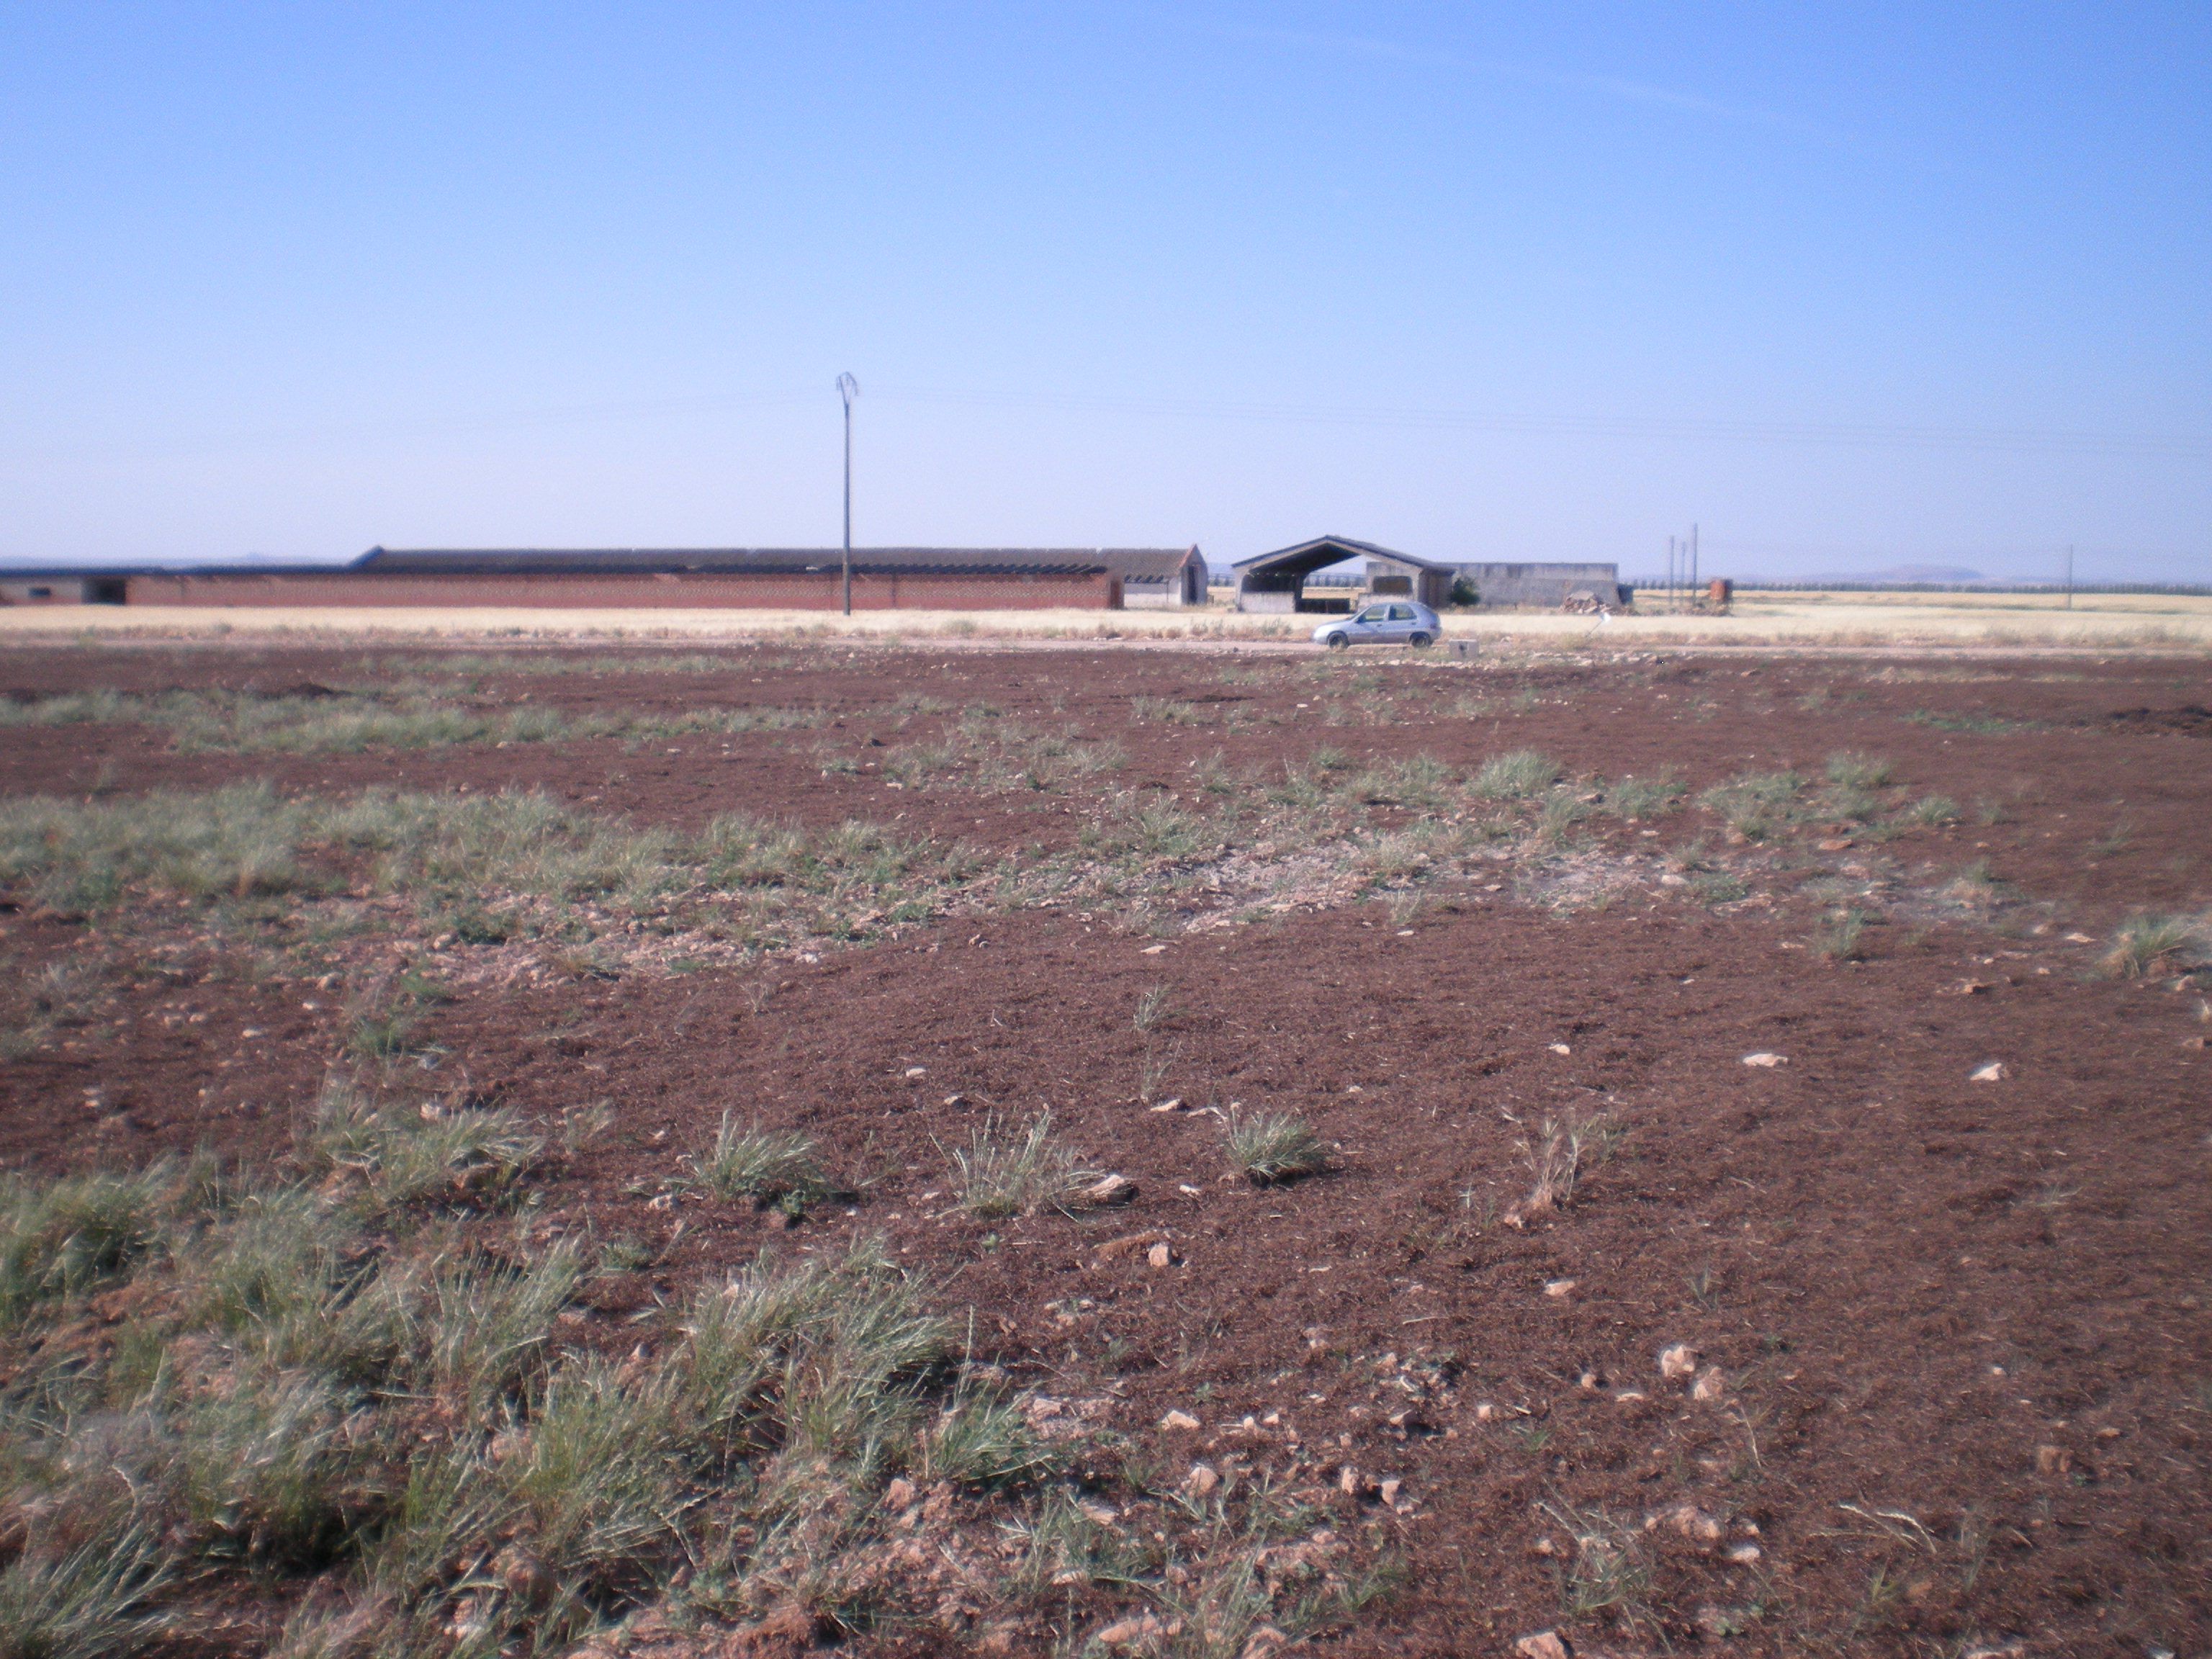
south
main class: Grassland
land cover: Spontaneously vegetated surfaces
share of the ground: 10 - 25 %
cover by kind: unconsolidated bare surface 85 %, herbaceous plants 15 %
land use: Agriculture (excluding fallow land and kitchen gardens)
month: May
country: ES
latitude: 39.0238
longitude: -3.5889
